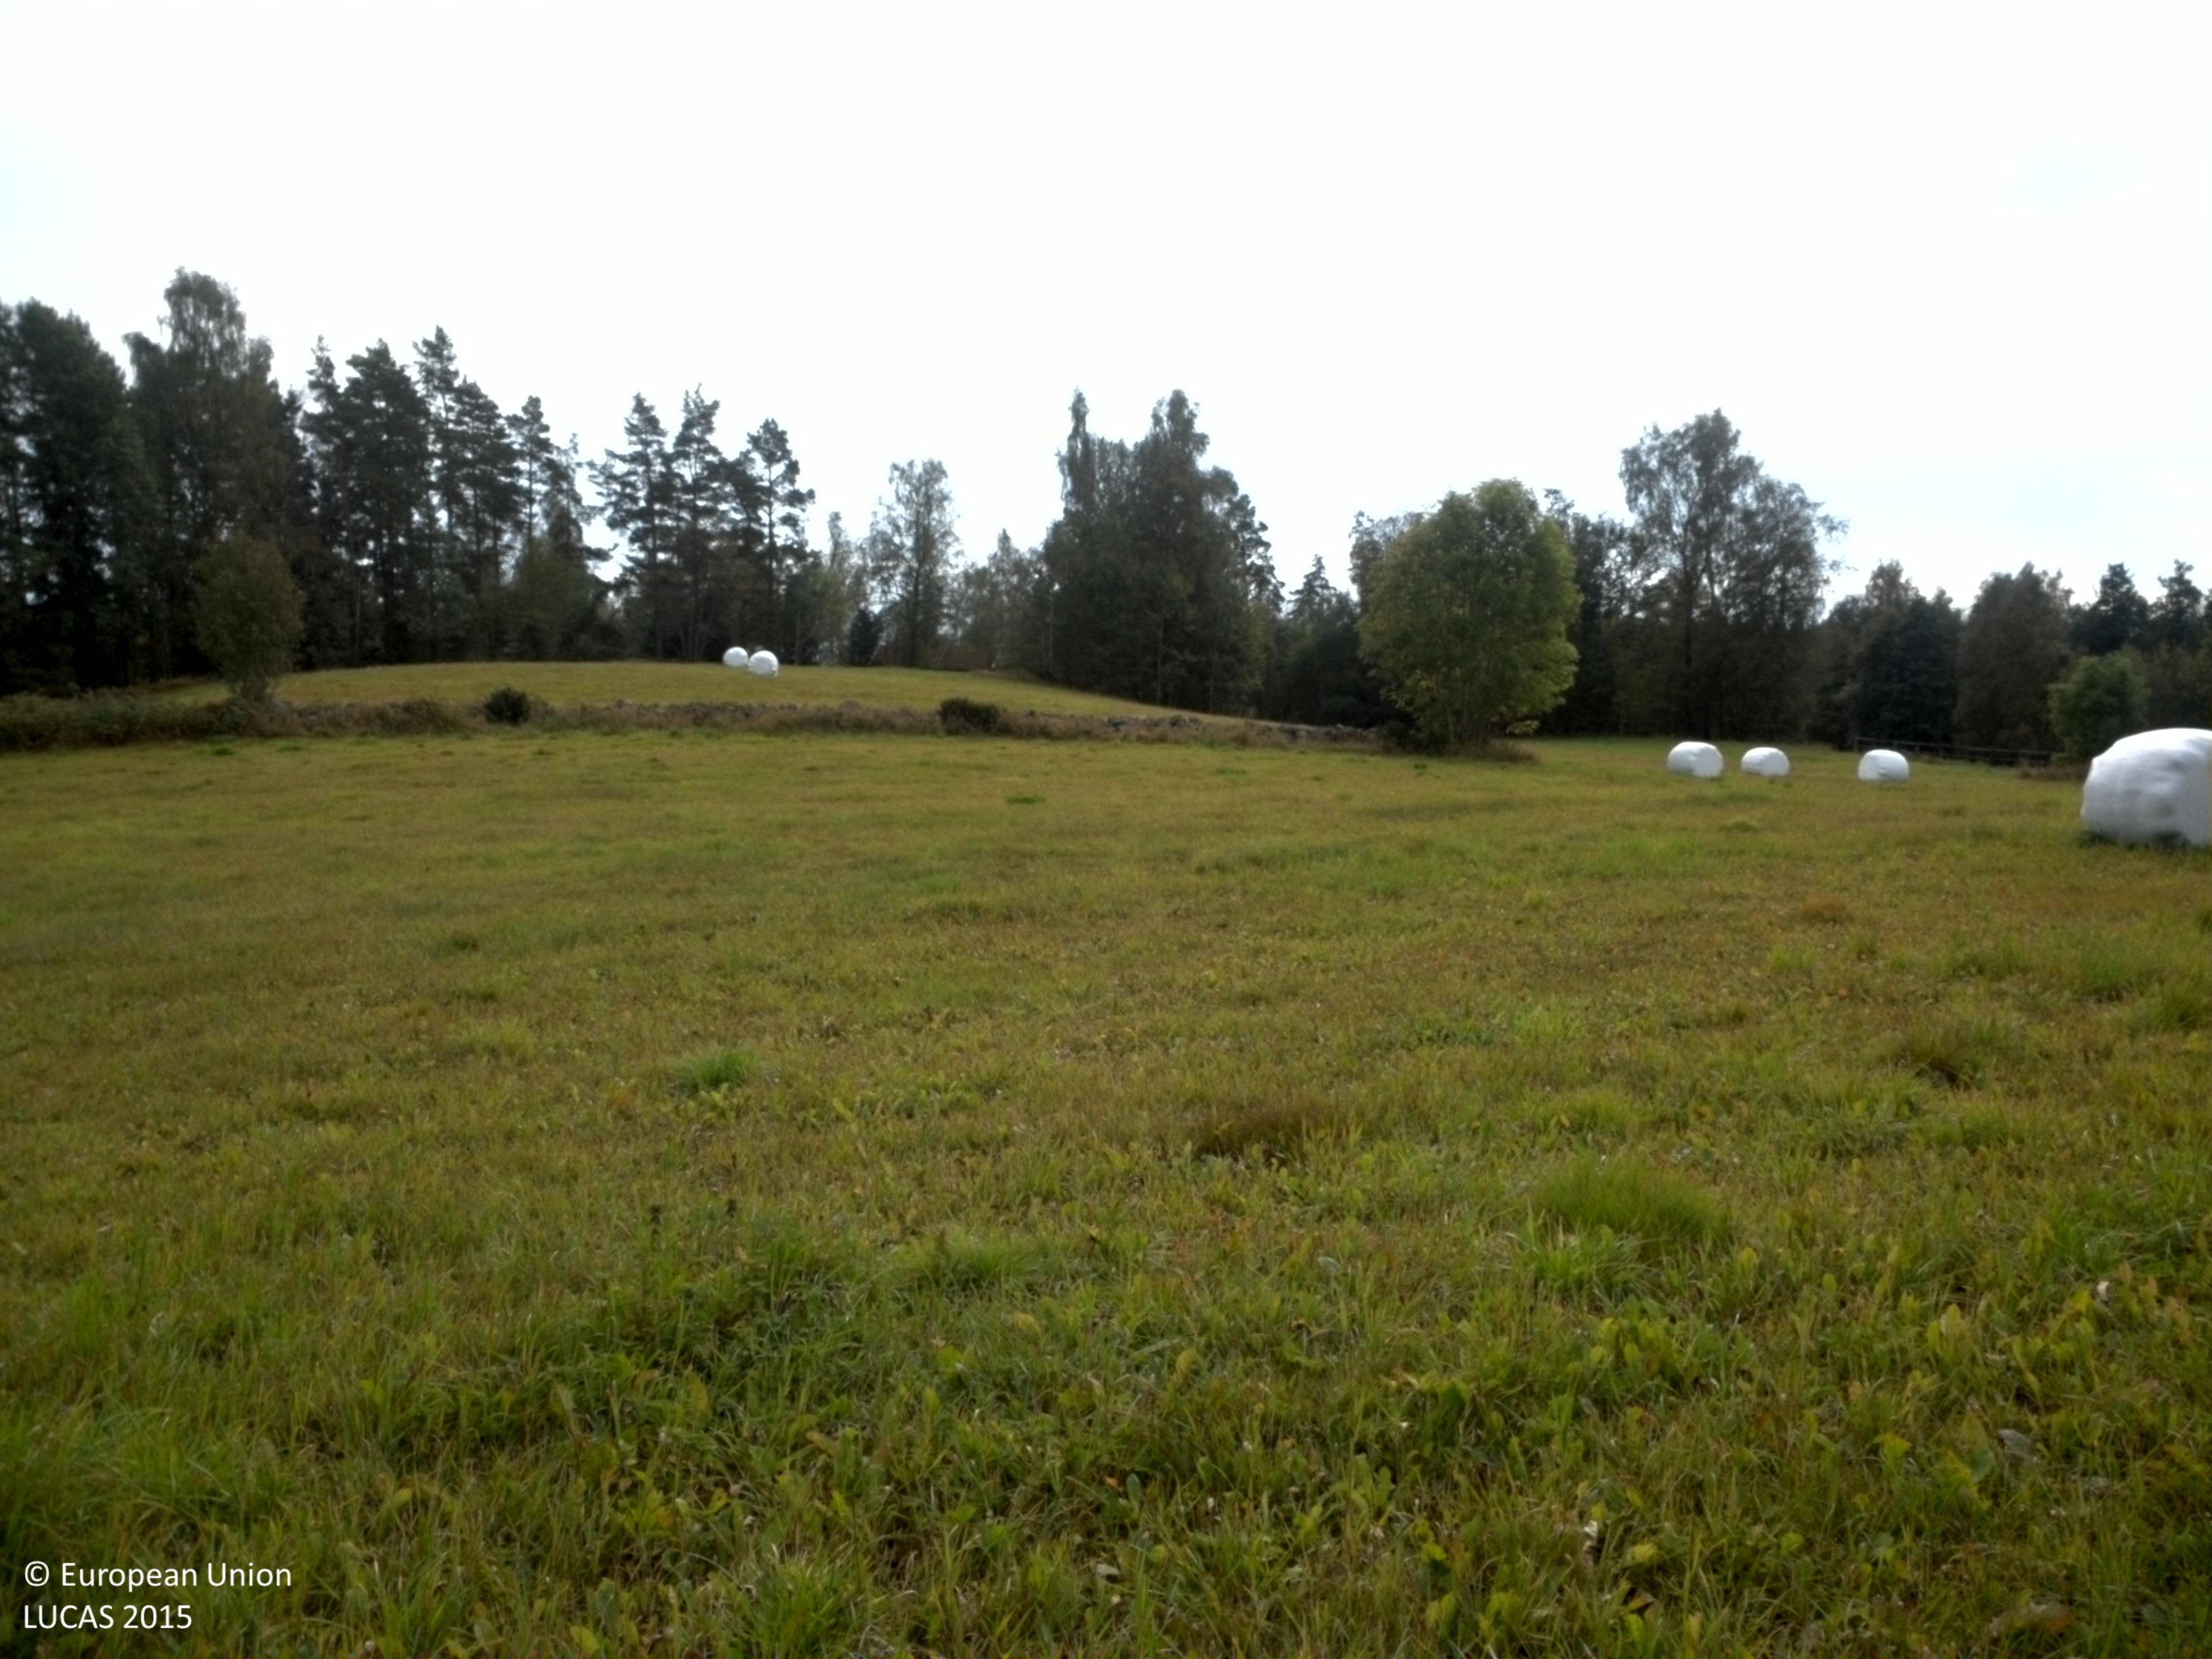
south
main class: Grassland
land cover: Grassland without tree/shrub cover
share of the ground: > 75 %
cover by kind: herbaceous plants 100 %
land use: Agriculture (excluding fallow land and kitchen gardens)
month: September
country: SE
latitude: 58.8700
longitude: 14.3455
